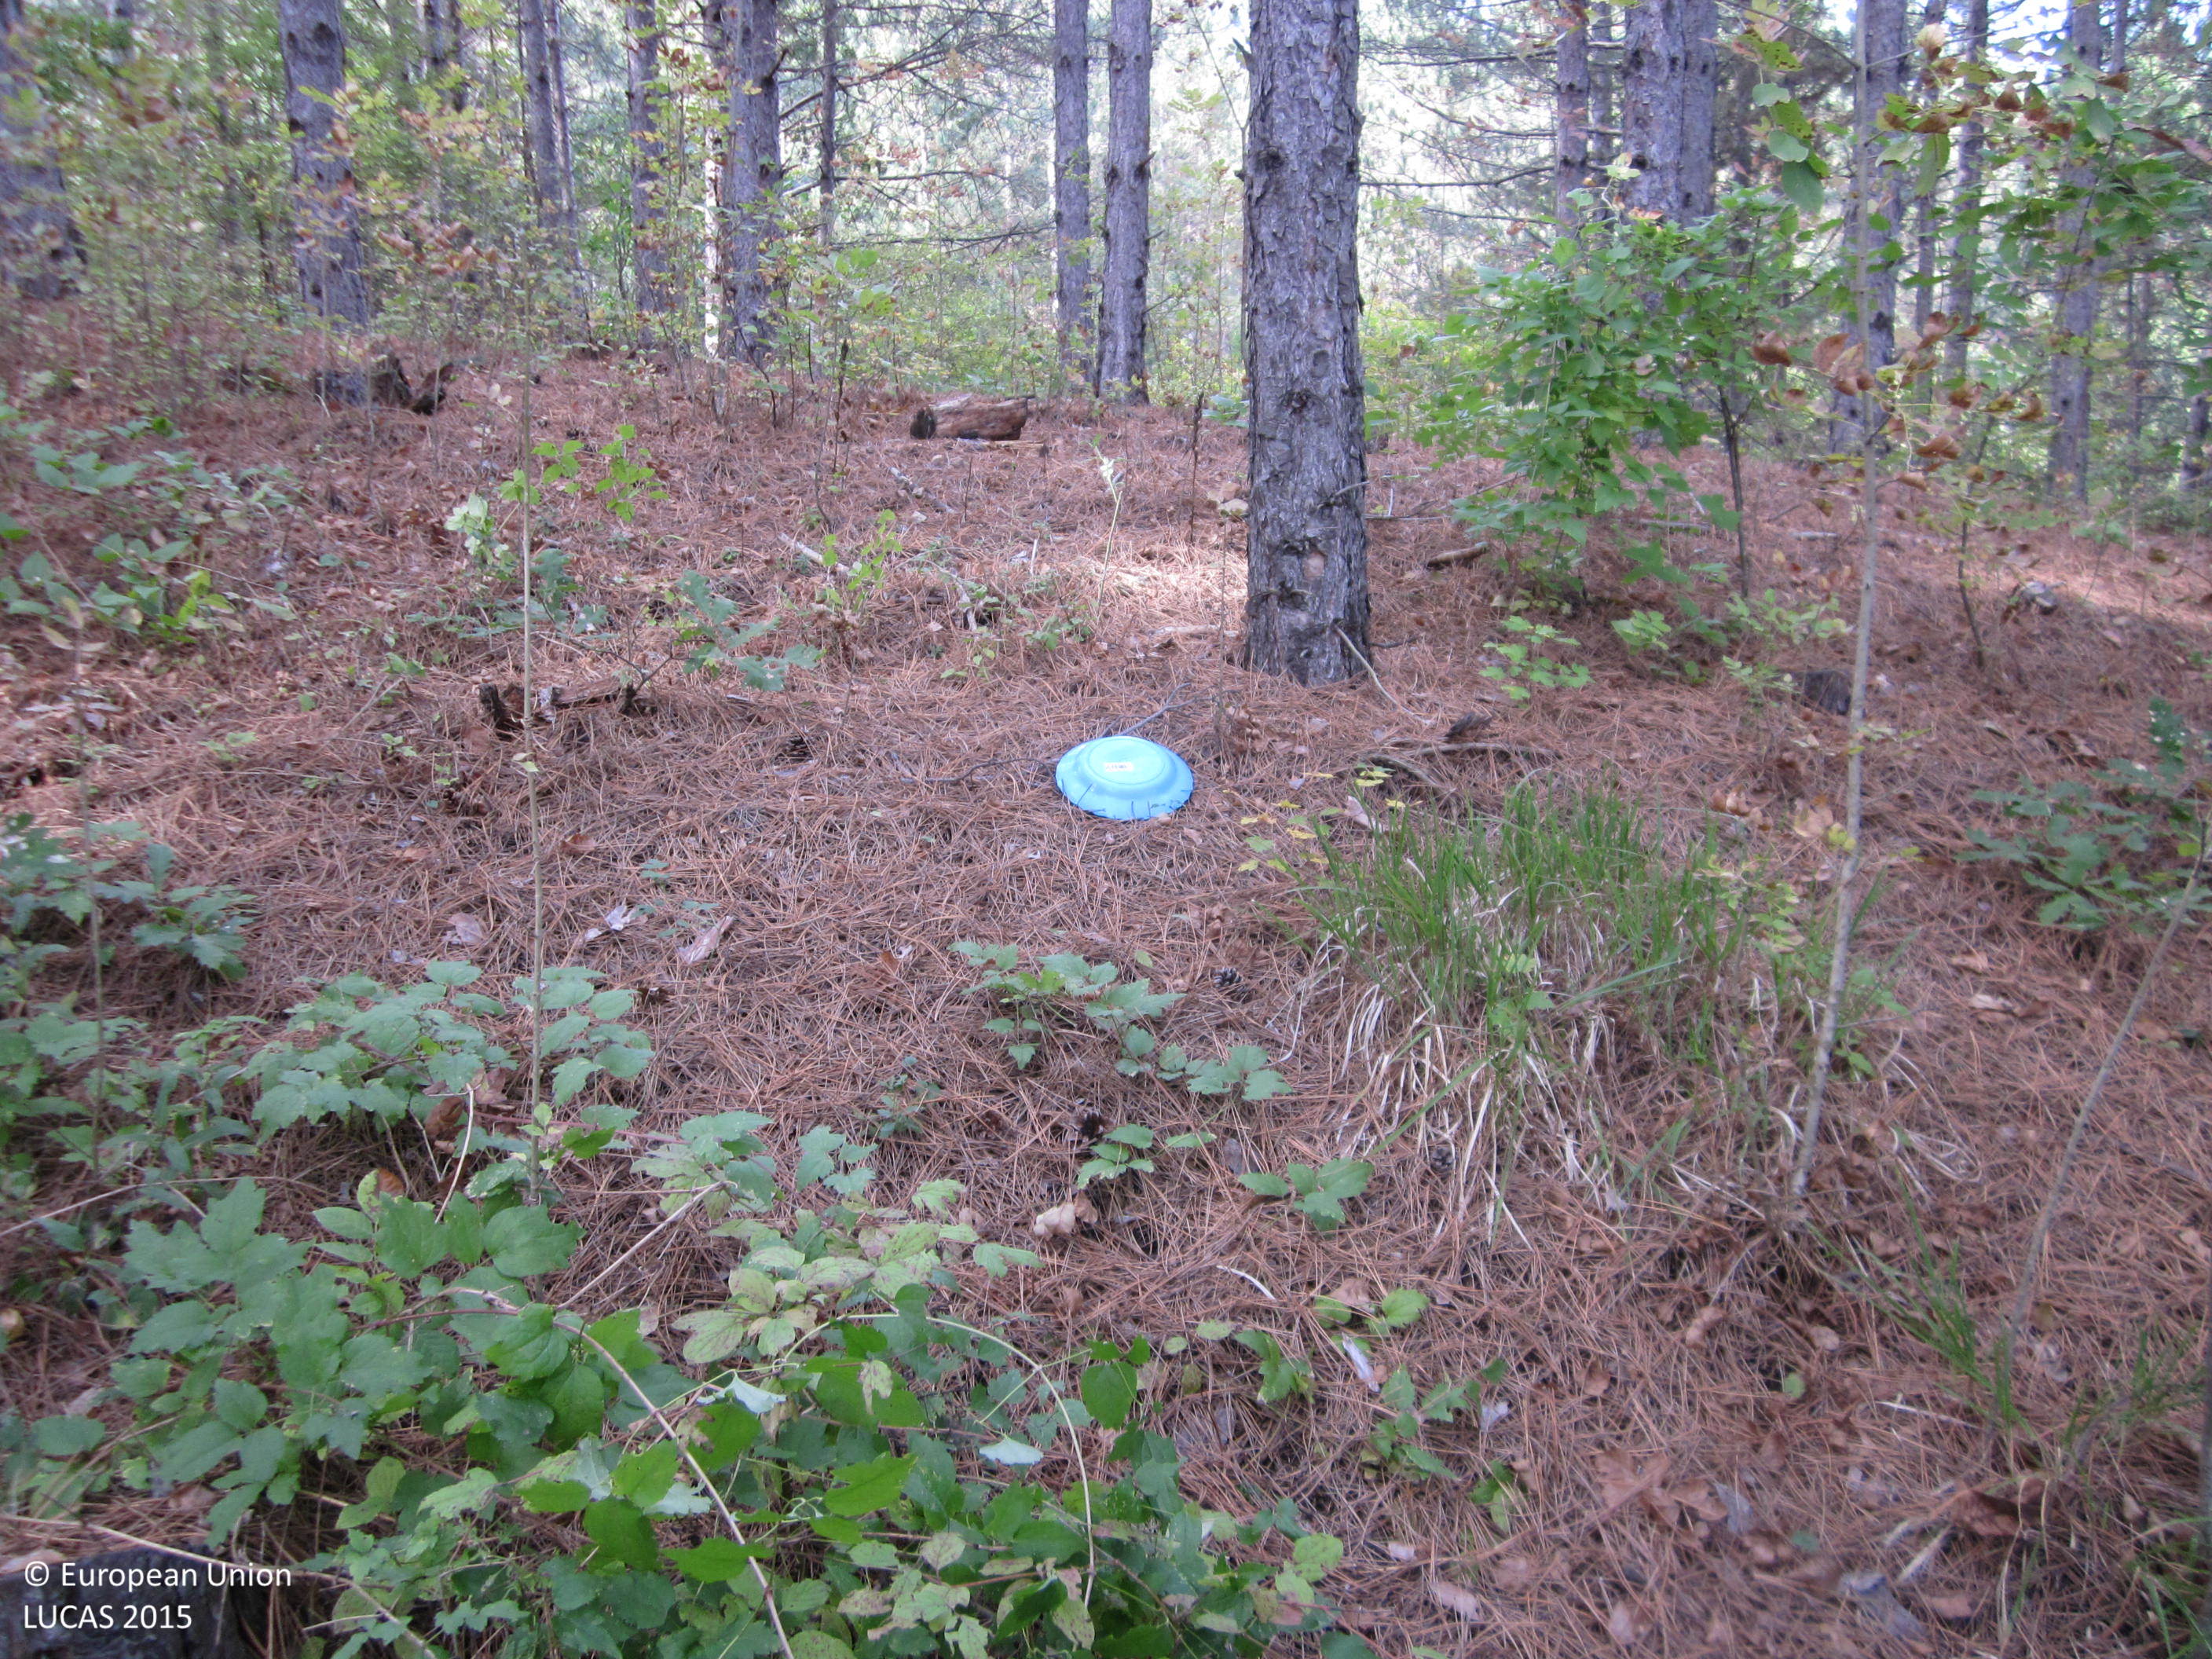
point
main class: Woodland
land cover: Pine dominated mixed woodland
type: hemiboreal forest and nemoral coniferous forest and mixed broadleaved-coniferous forest
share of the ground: > 75 %
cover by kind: coniferous forest trees 60 %, broadleaved forest trees 20 %, unconsolidated bare surface 15 %, herbaceous plants 5 %
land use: Forestry
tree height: > 5 m
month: October
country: BG
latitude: 42.8488
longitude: 26.8577
